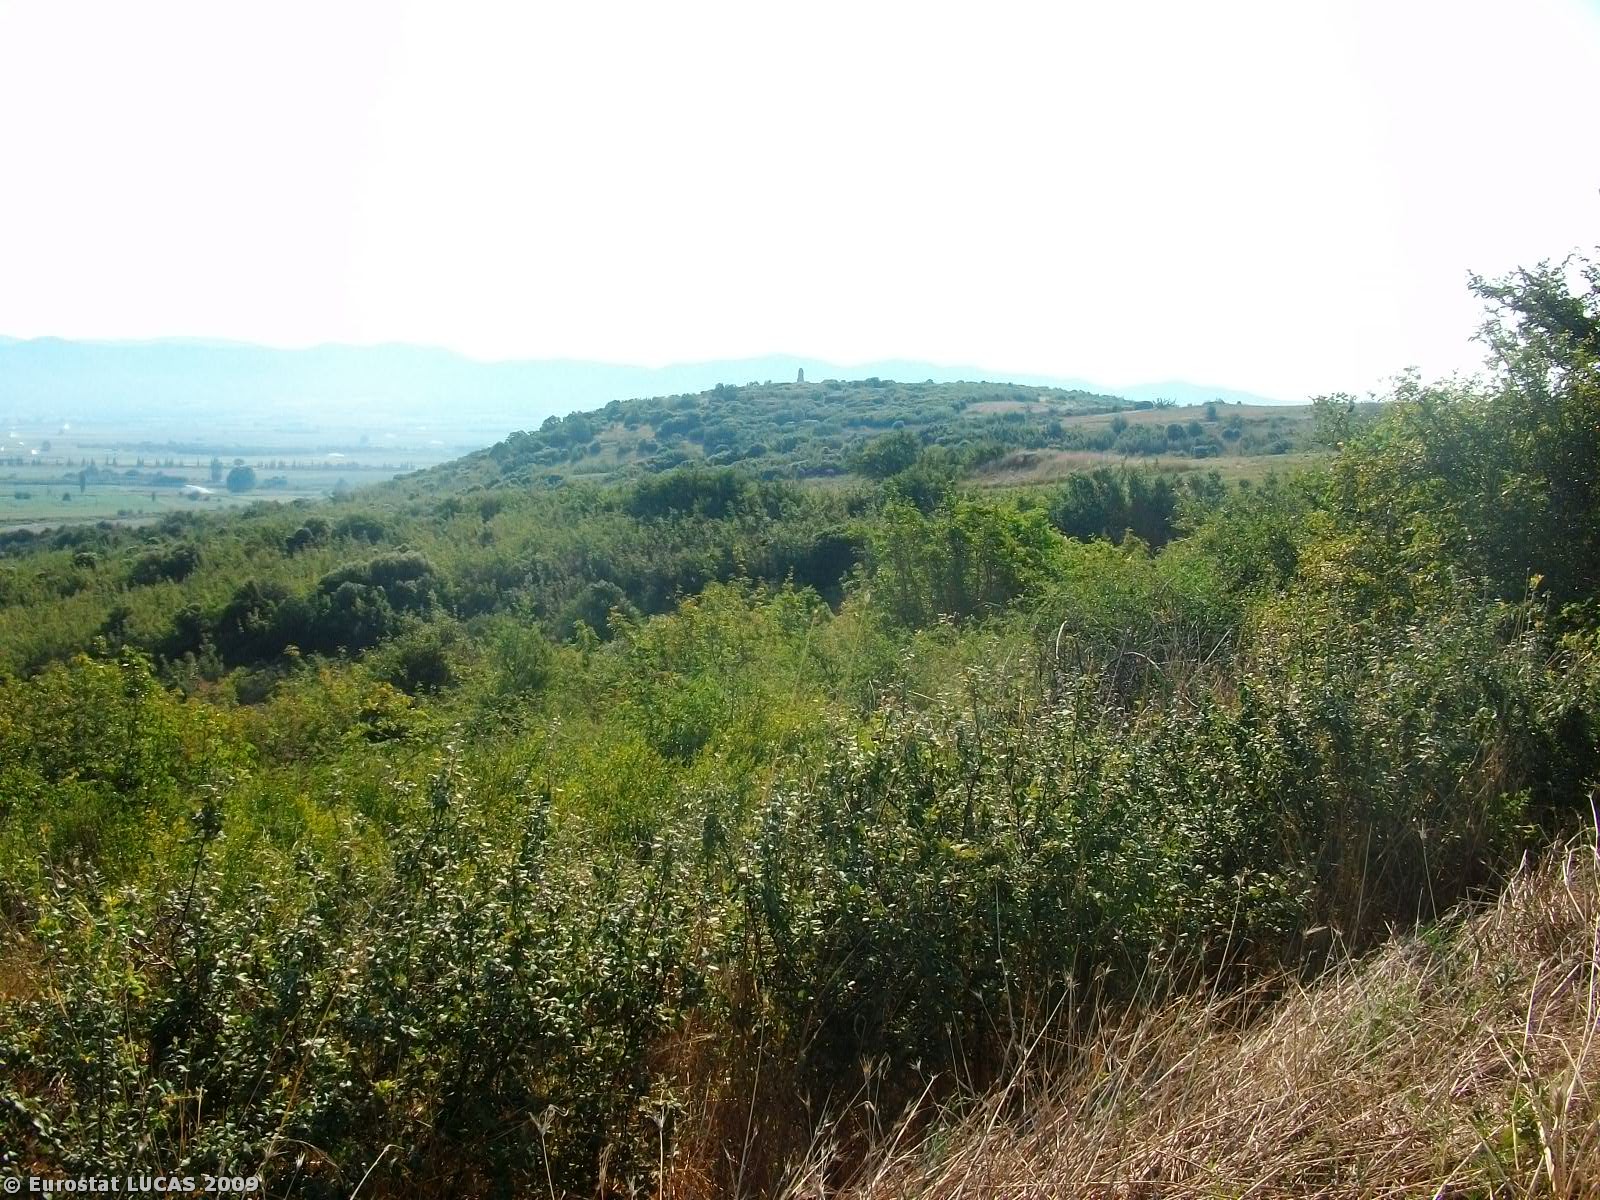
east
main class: Shrubland
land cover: Shrubland without tree cover
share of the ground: > 75 %
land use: Unused
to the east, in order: Shrubland without tree cover; Barley; Shrubland without tree cover
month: July
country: GR
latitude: 41.1685
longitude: 22.7522
